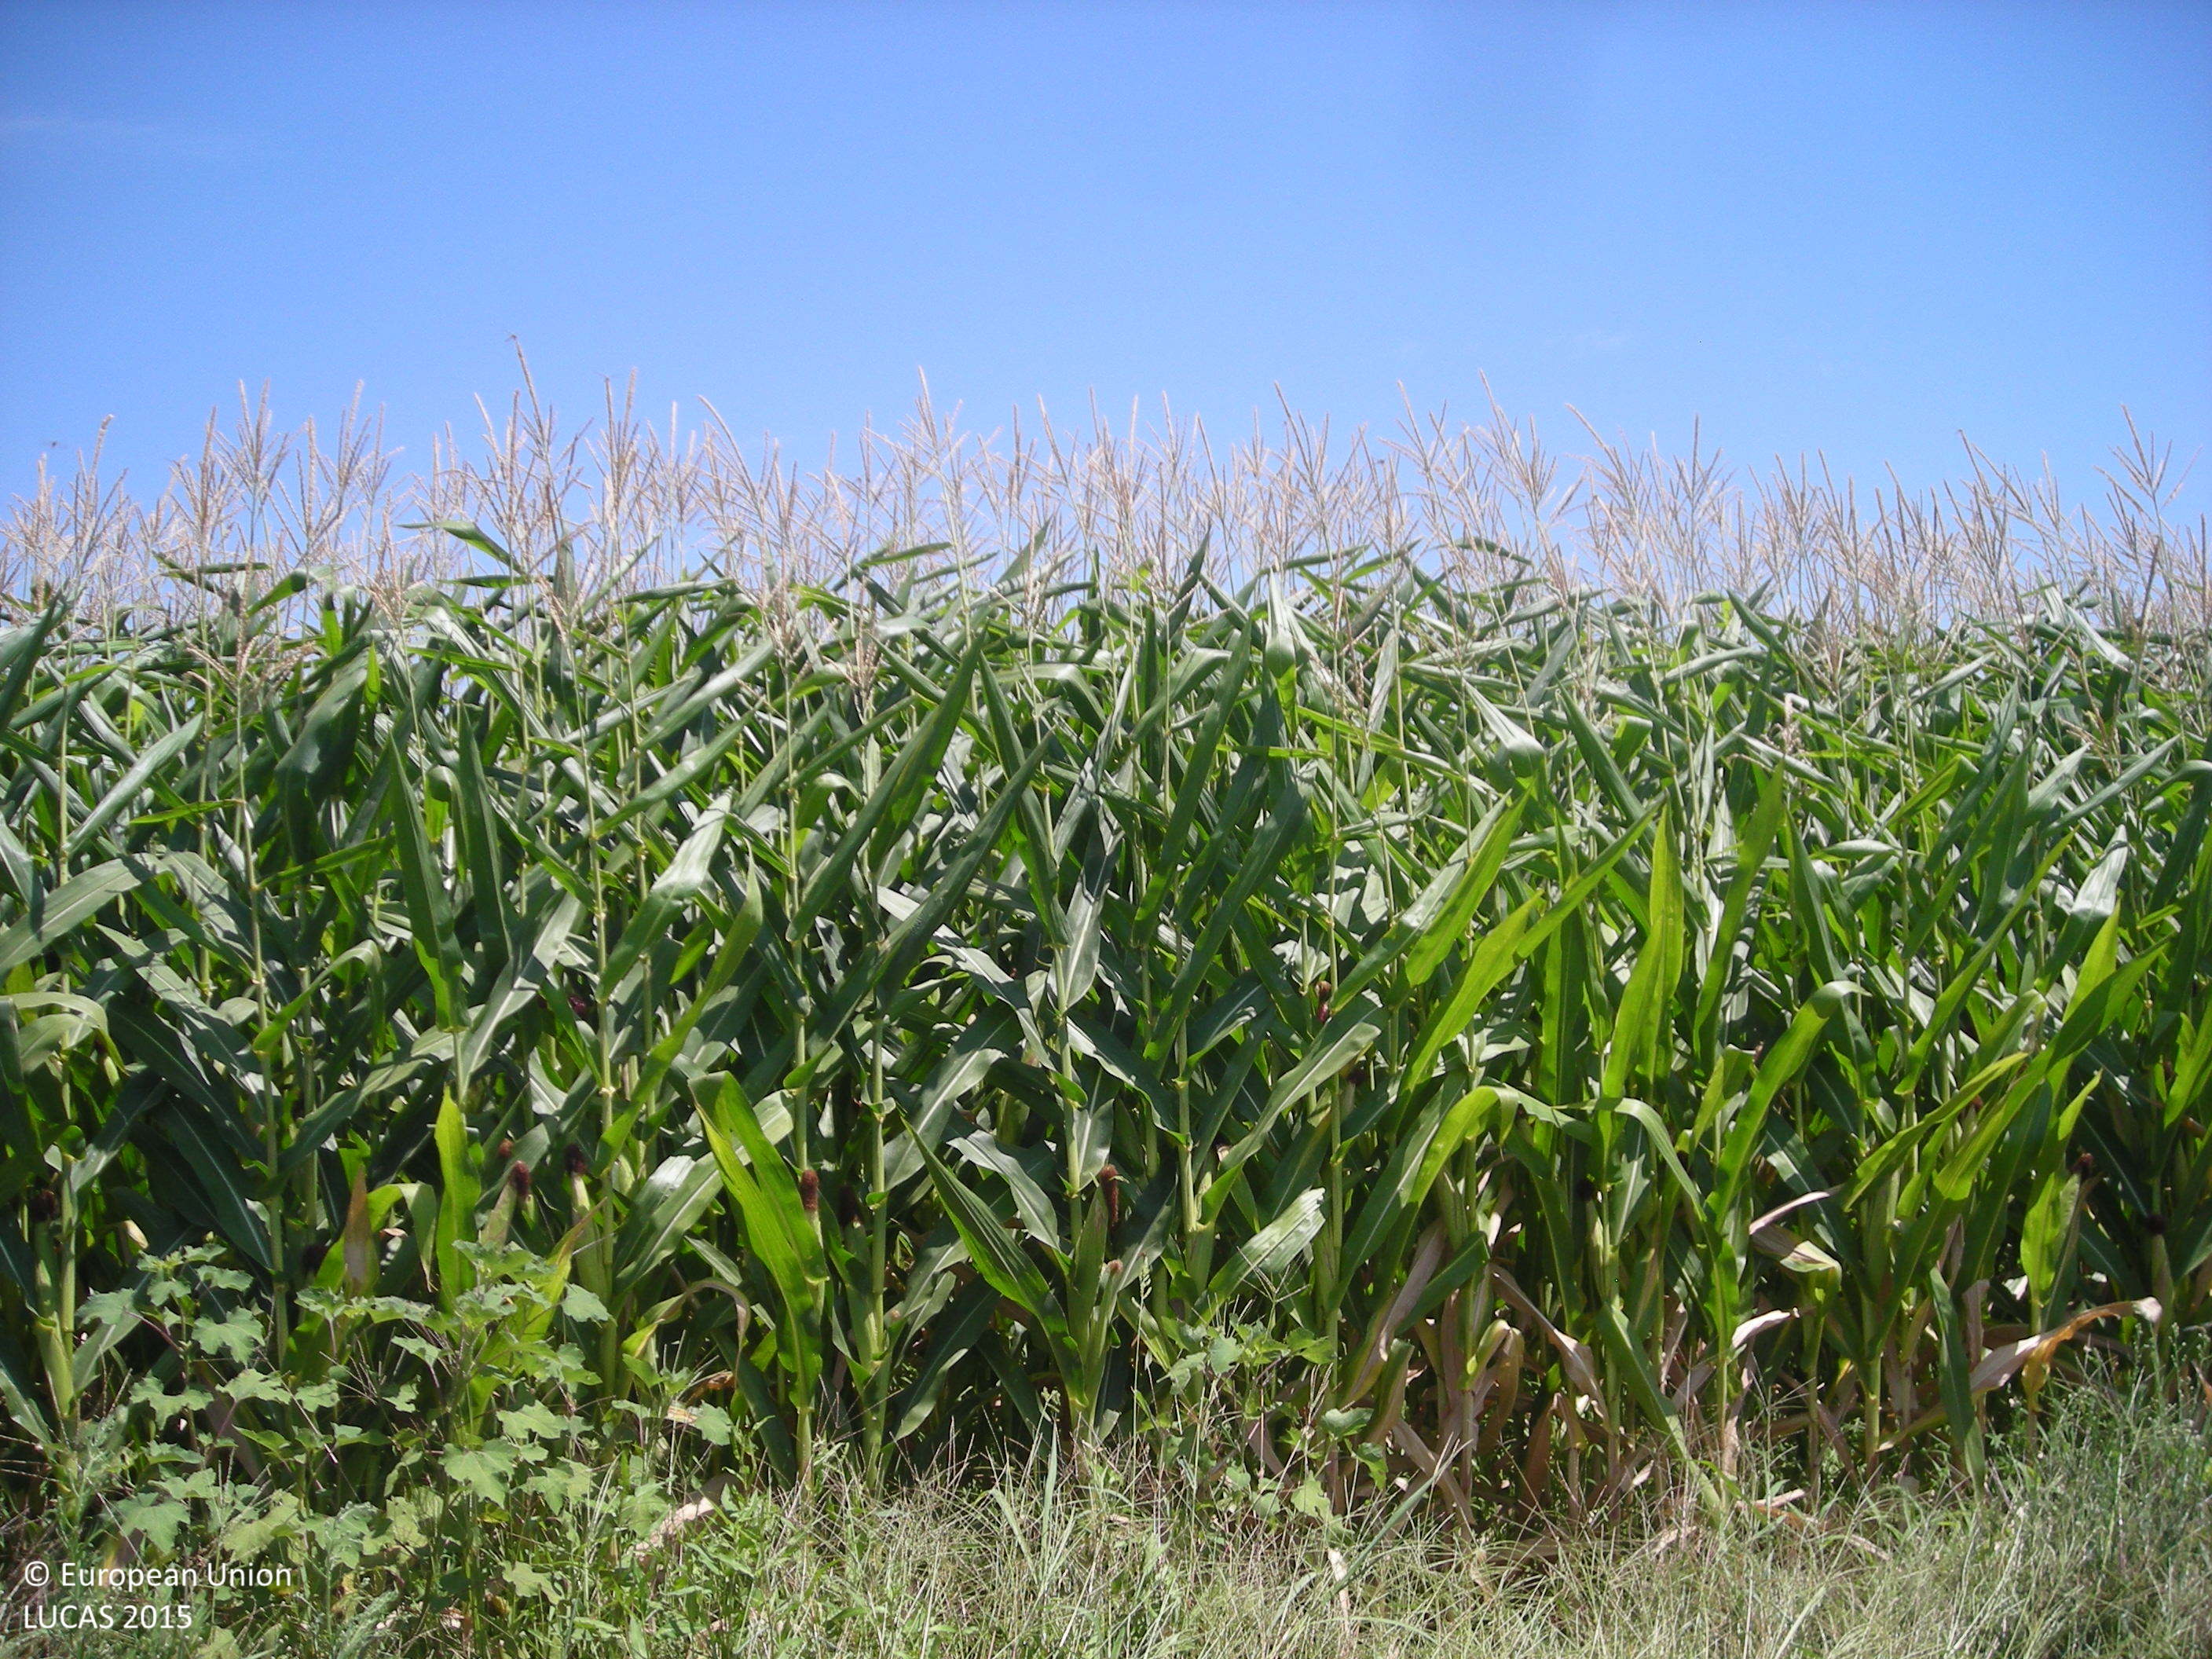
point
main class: Cropland
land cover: Maize
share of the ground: > 75 %
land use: Agriculture (excluding fallow land and kitchen gardens)
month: July
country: ES
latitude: 39.0430
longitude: -5.9621
